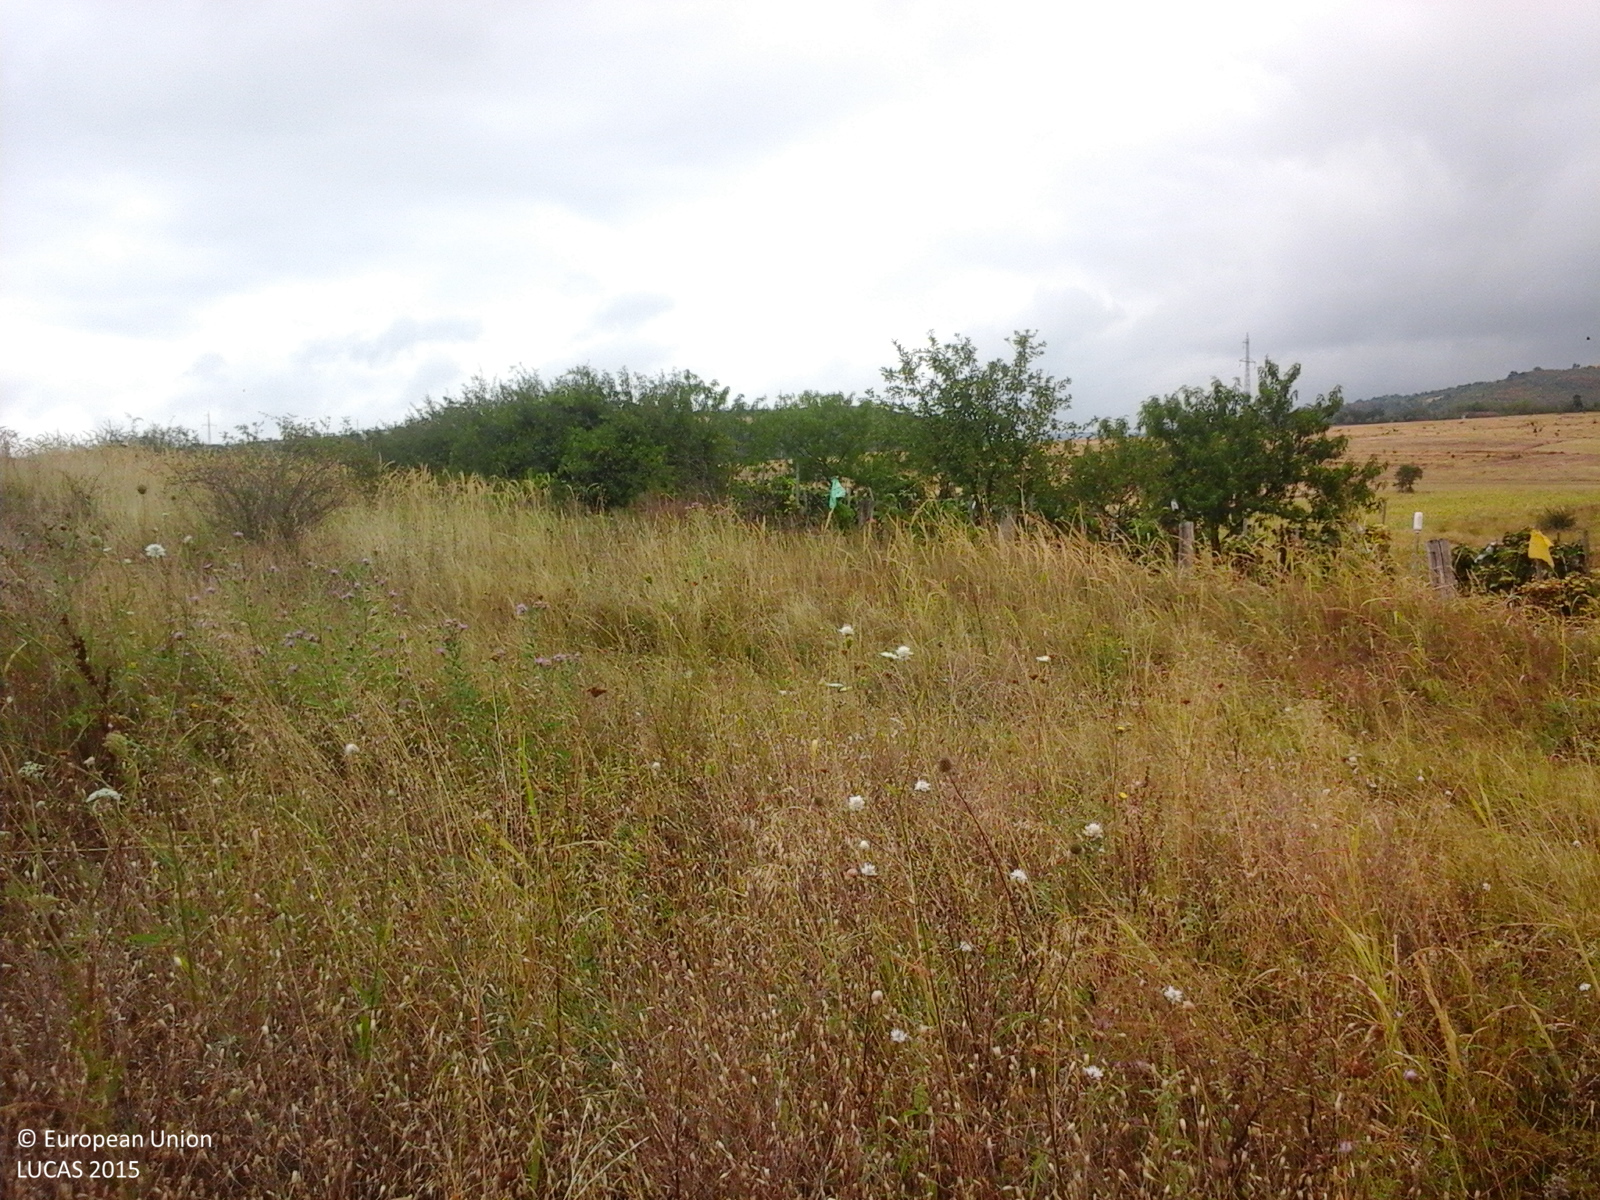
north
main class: Grassland
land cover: Spontaneously vegetated surfaces
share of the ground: > 75 %
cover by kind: herbaceous plants 100 %
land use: Fallow land
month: August
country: RO
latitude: 44.7727
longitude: 21.5907
